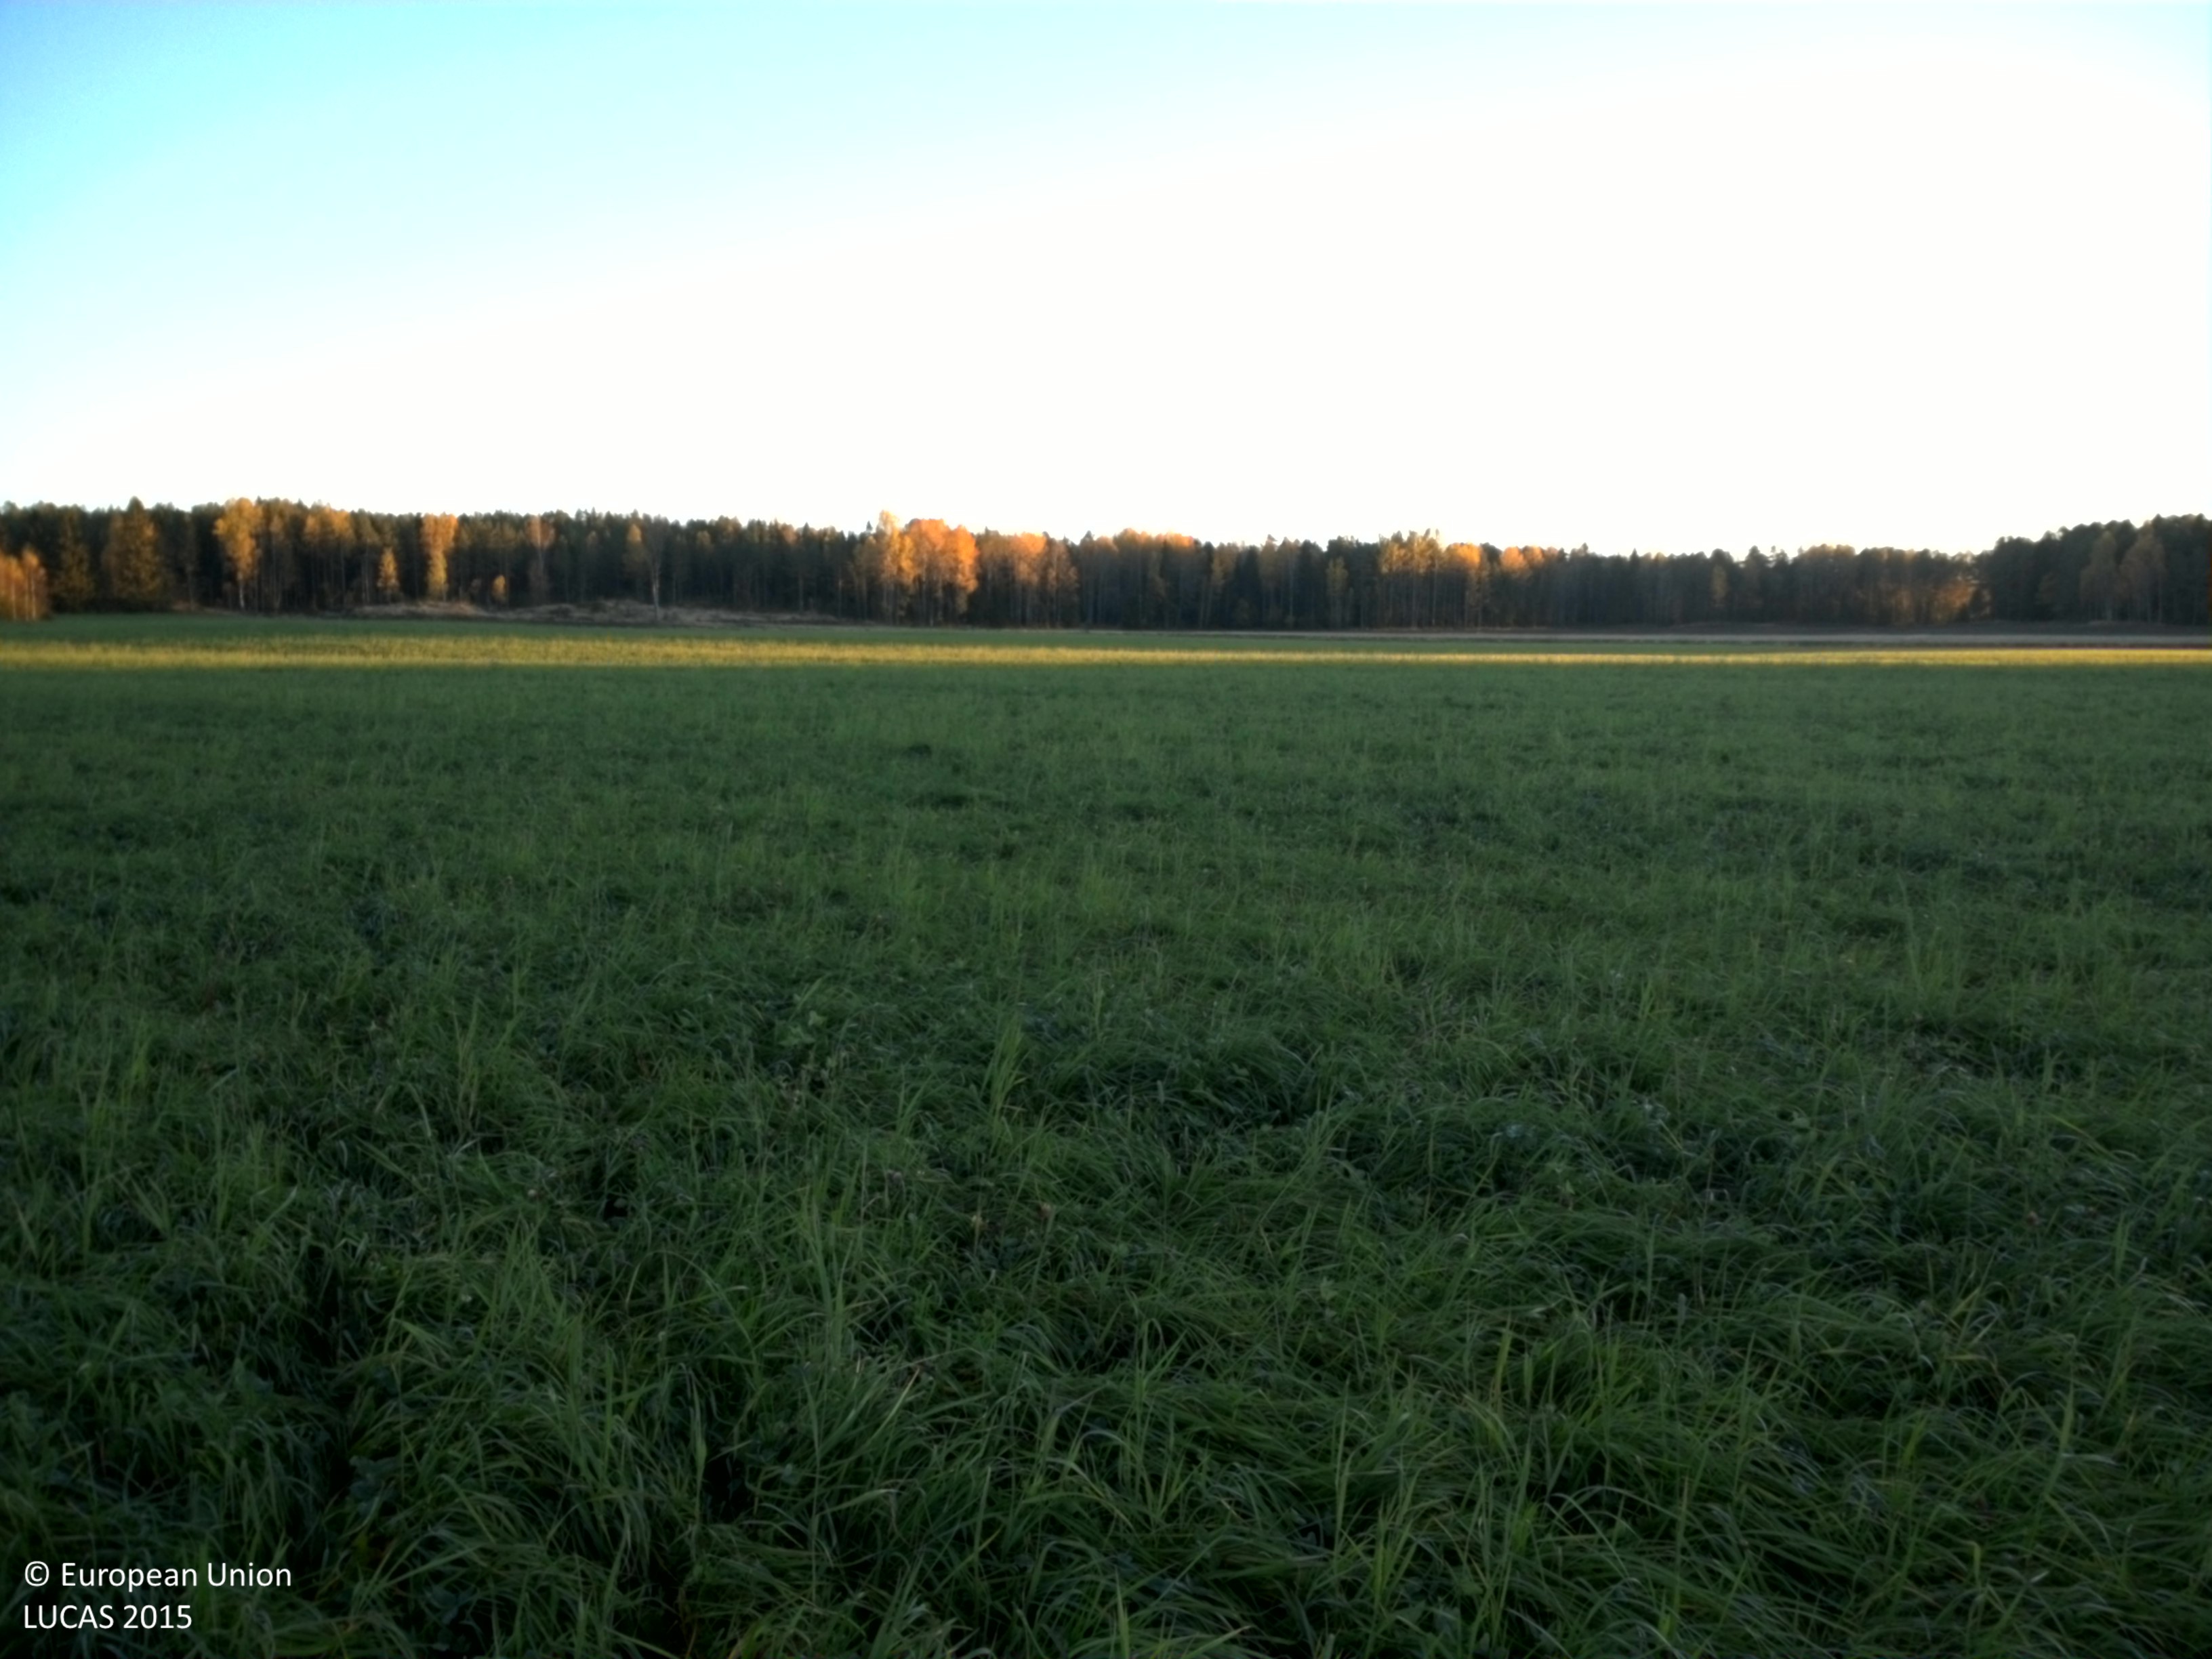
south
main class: Grassland
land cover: Grassland without tree/shrub cover
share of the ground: > 75 %
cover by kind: herbaceous plants 100 %
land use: Agriculture (excluding fallow land and kitchen gardens)
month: October
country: SE
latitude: 59.1555
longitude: 13.1232
